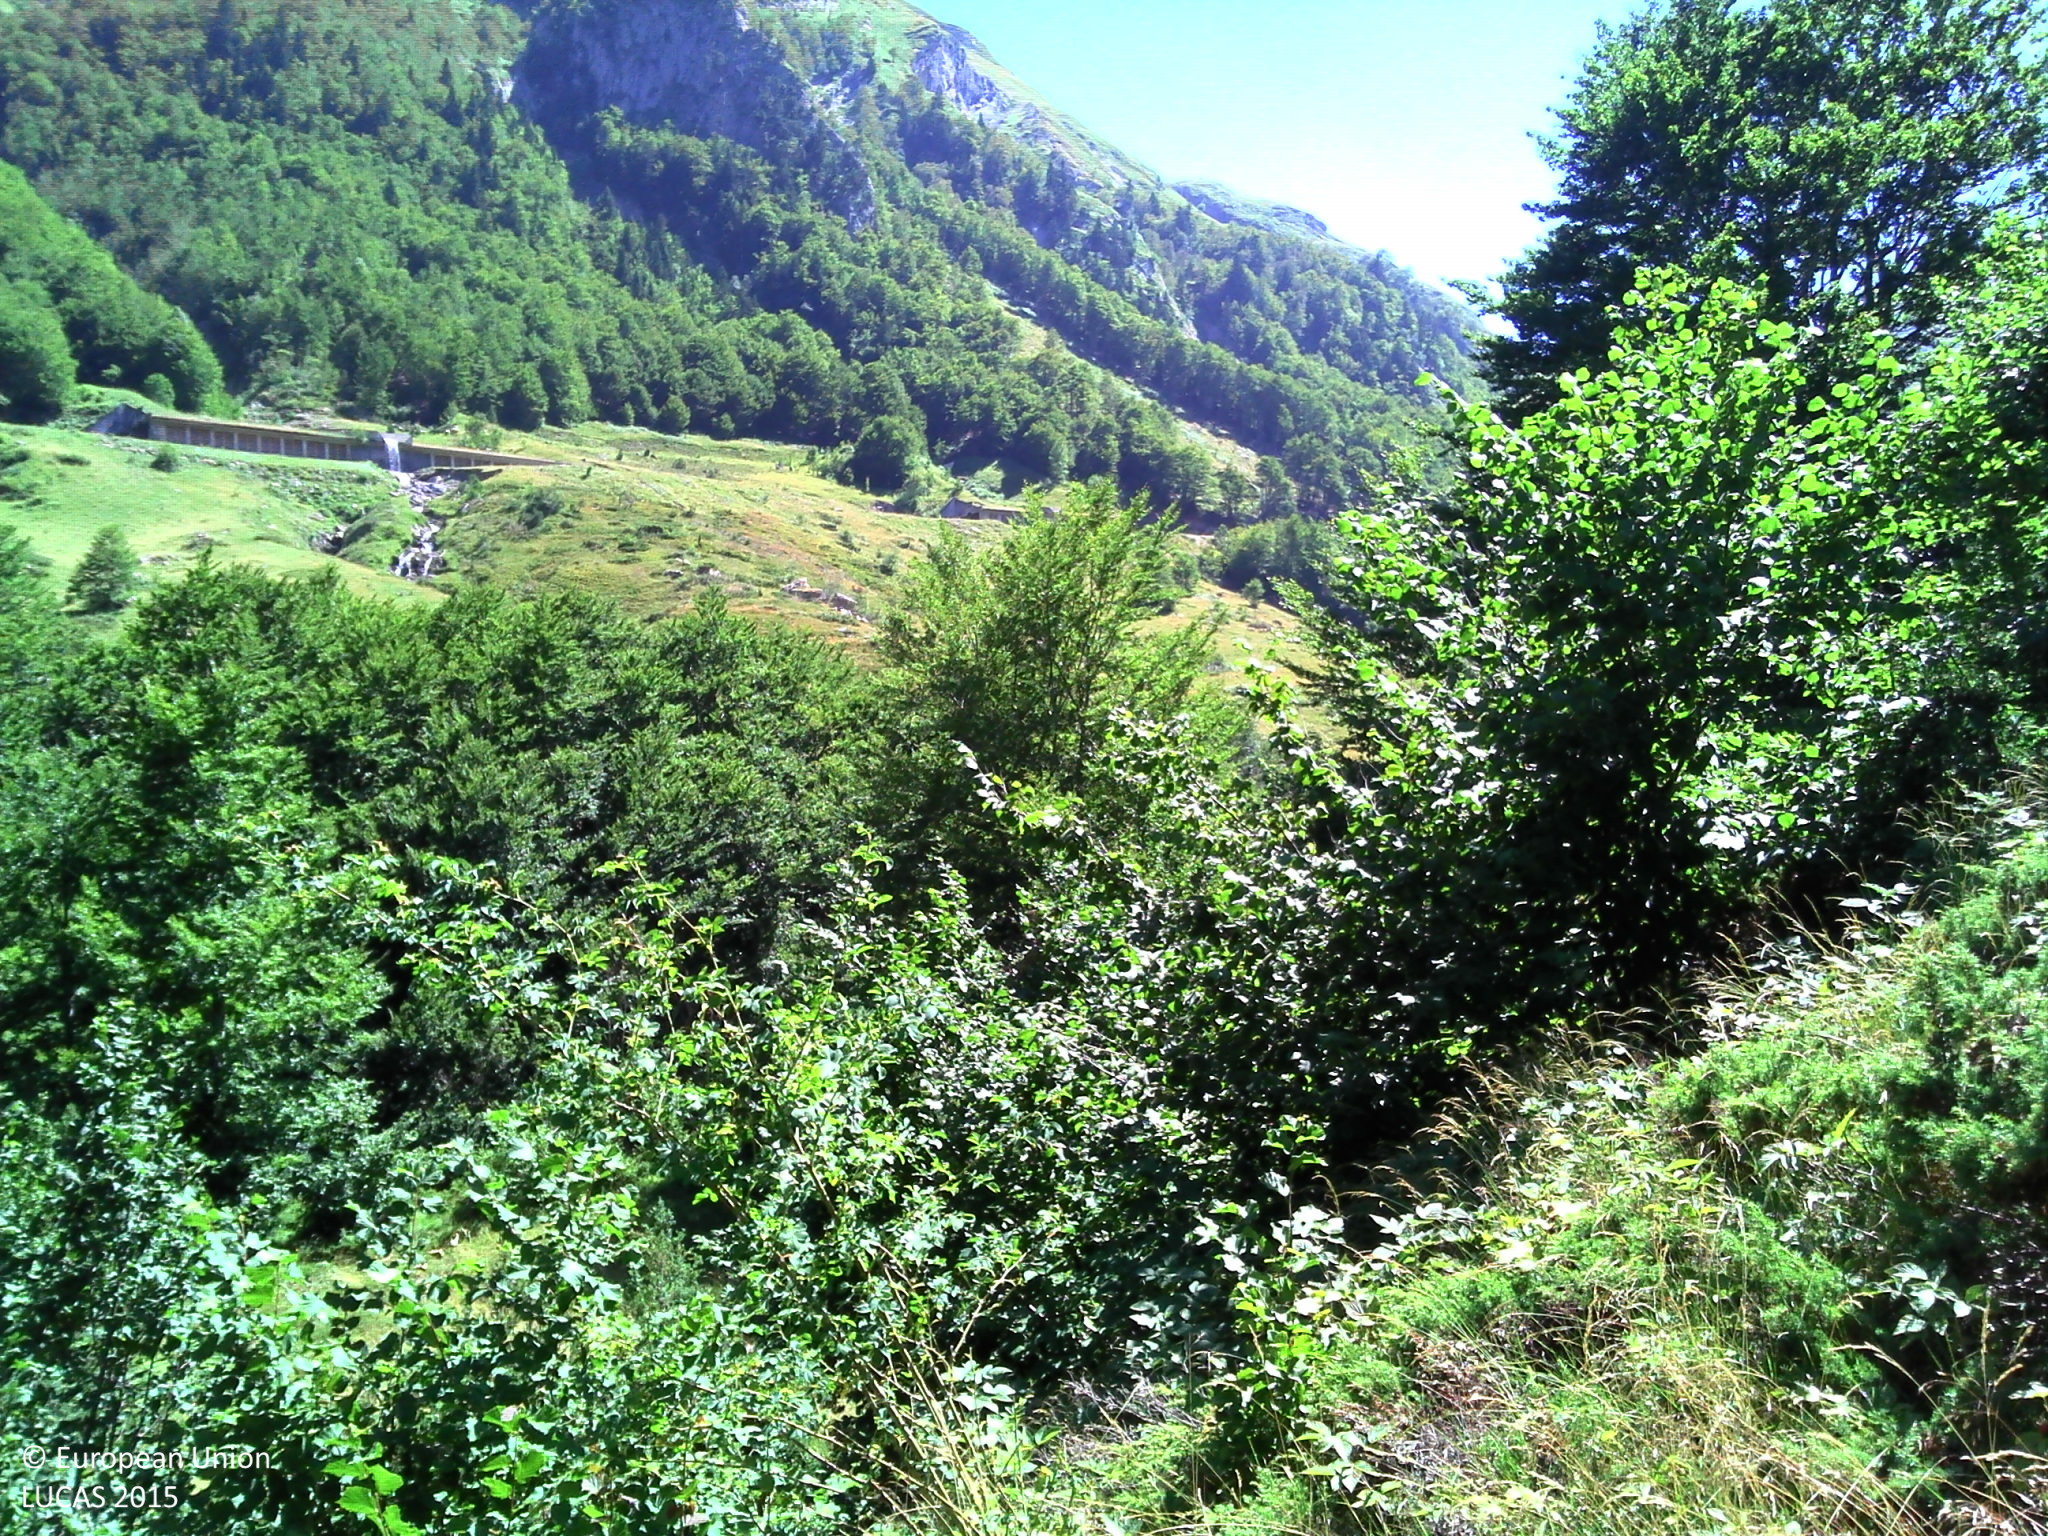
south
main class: Woodland
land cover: Broadleaved woodland
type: beech forest
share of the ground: 25 - 50 %
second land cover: Grassland without tree/shrub cover
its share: 50 - 75 %
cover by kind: herbaceous plants 40 %, broadleaved forest trees 35 %, shrubs 15 %, lichens and mosses 5 %, consolidated bare surface 5 %
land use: Forestry
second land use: Agriculture (excluding fallow land and kitchen gardens)
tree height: > 5 m
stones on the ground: 10 - 25 %
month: July
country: FR
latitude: 42.8278
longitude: -0.3890
